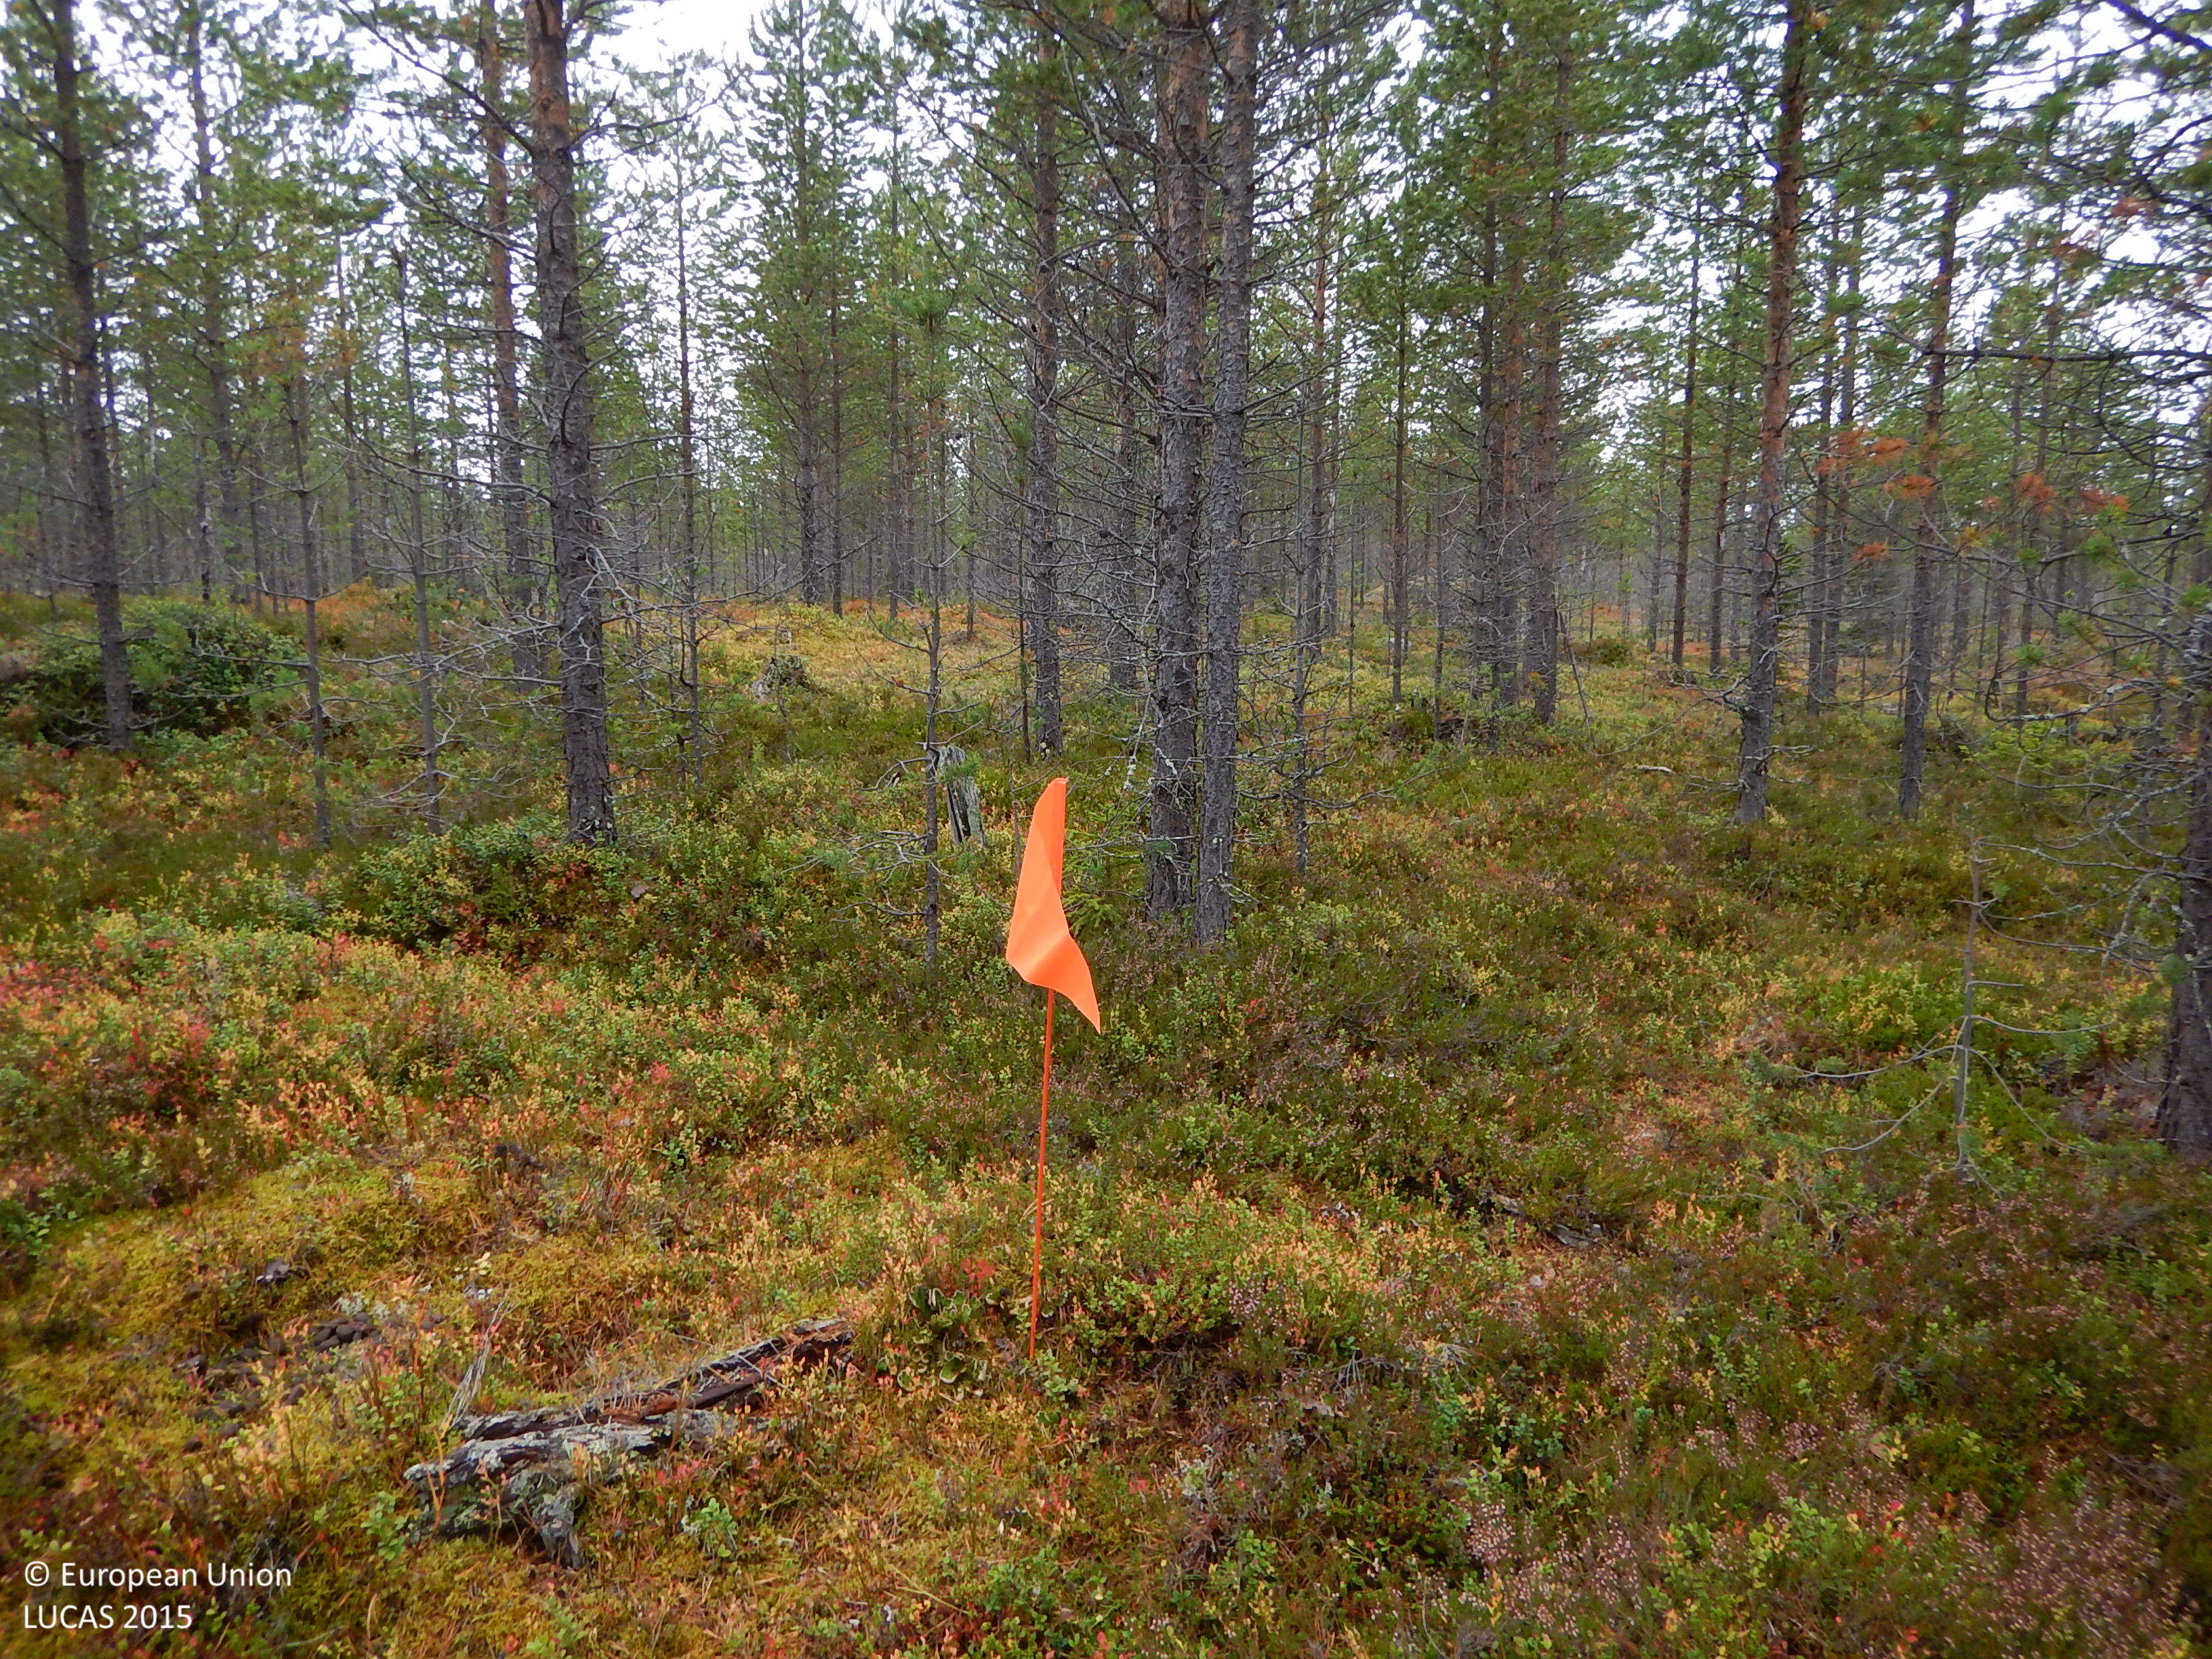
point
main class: Woodland
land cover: Pine dominated coniferous woodland
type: boreal forest
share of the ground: 25 - 50 %
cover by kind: shrubs 40 %, coniferous forest trees 35 %, lichens and mosses 15 %, herbaceous plants 10 %
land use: Forestry
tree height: < 5 m
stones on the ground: < 10 %
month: September
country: SE
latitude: 65.1708
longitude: 19.1632
